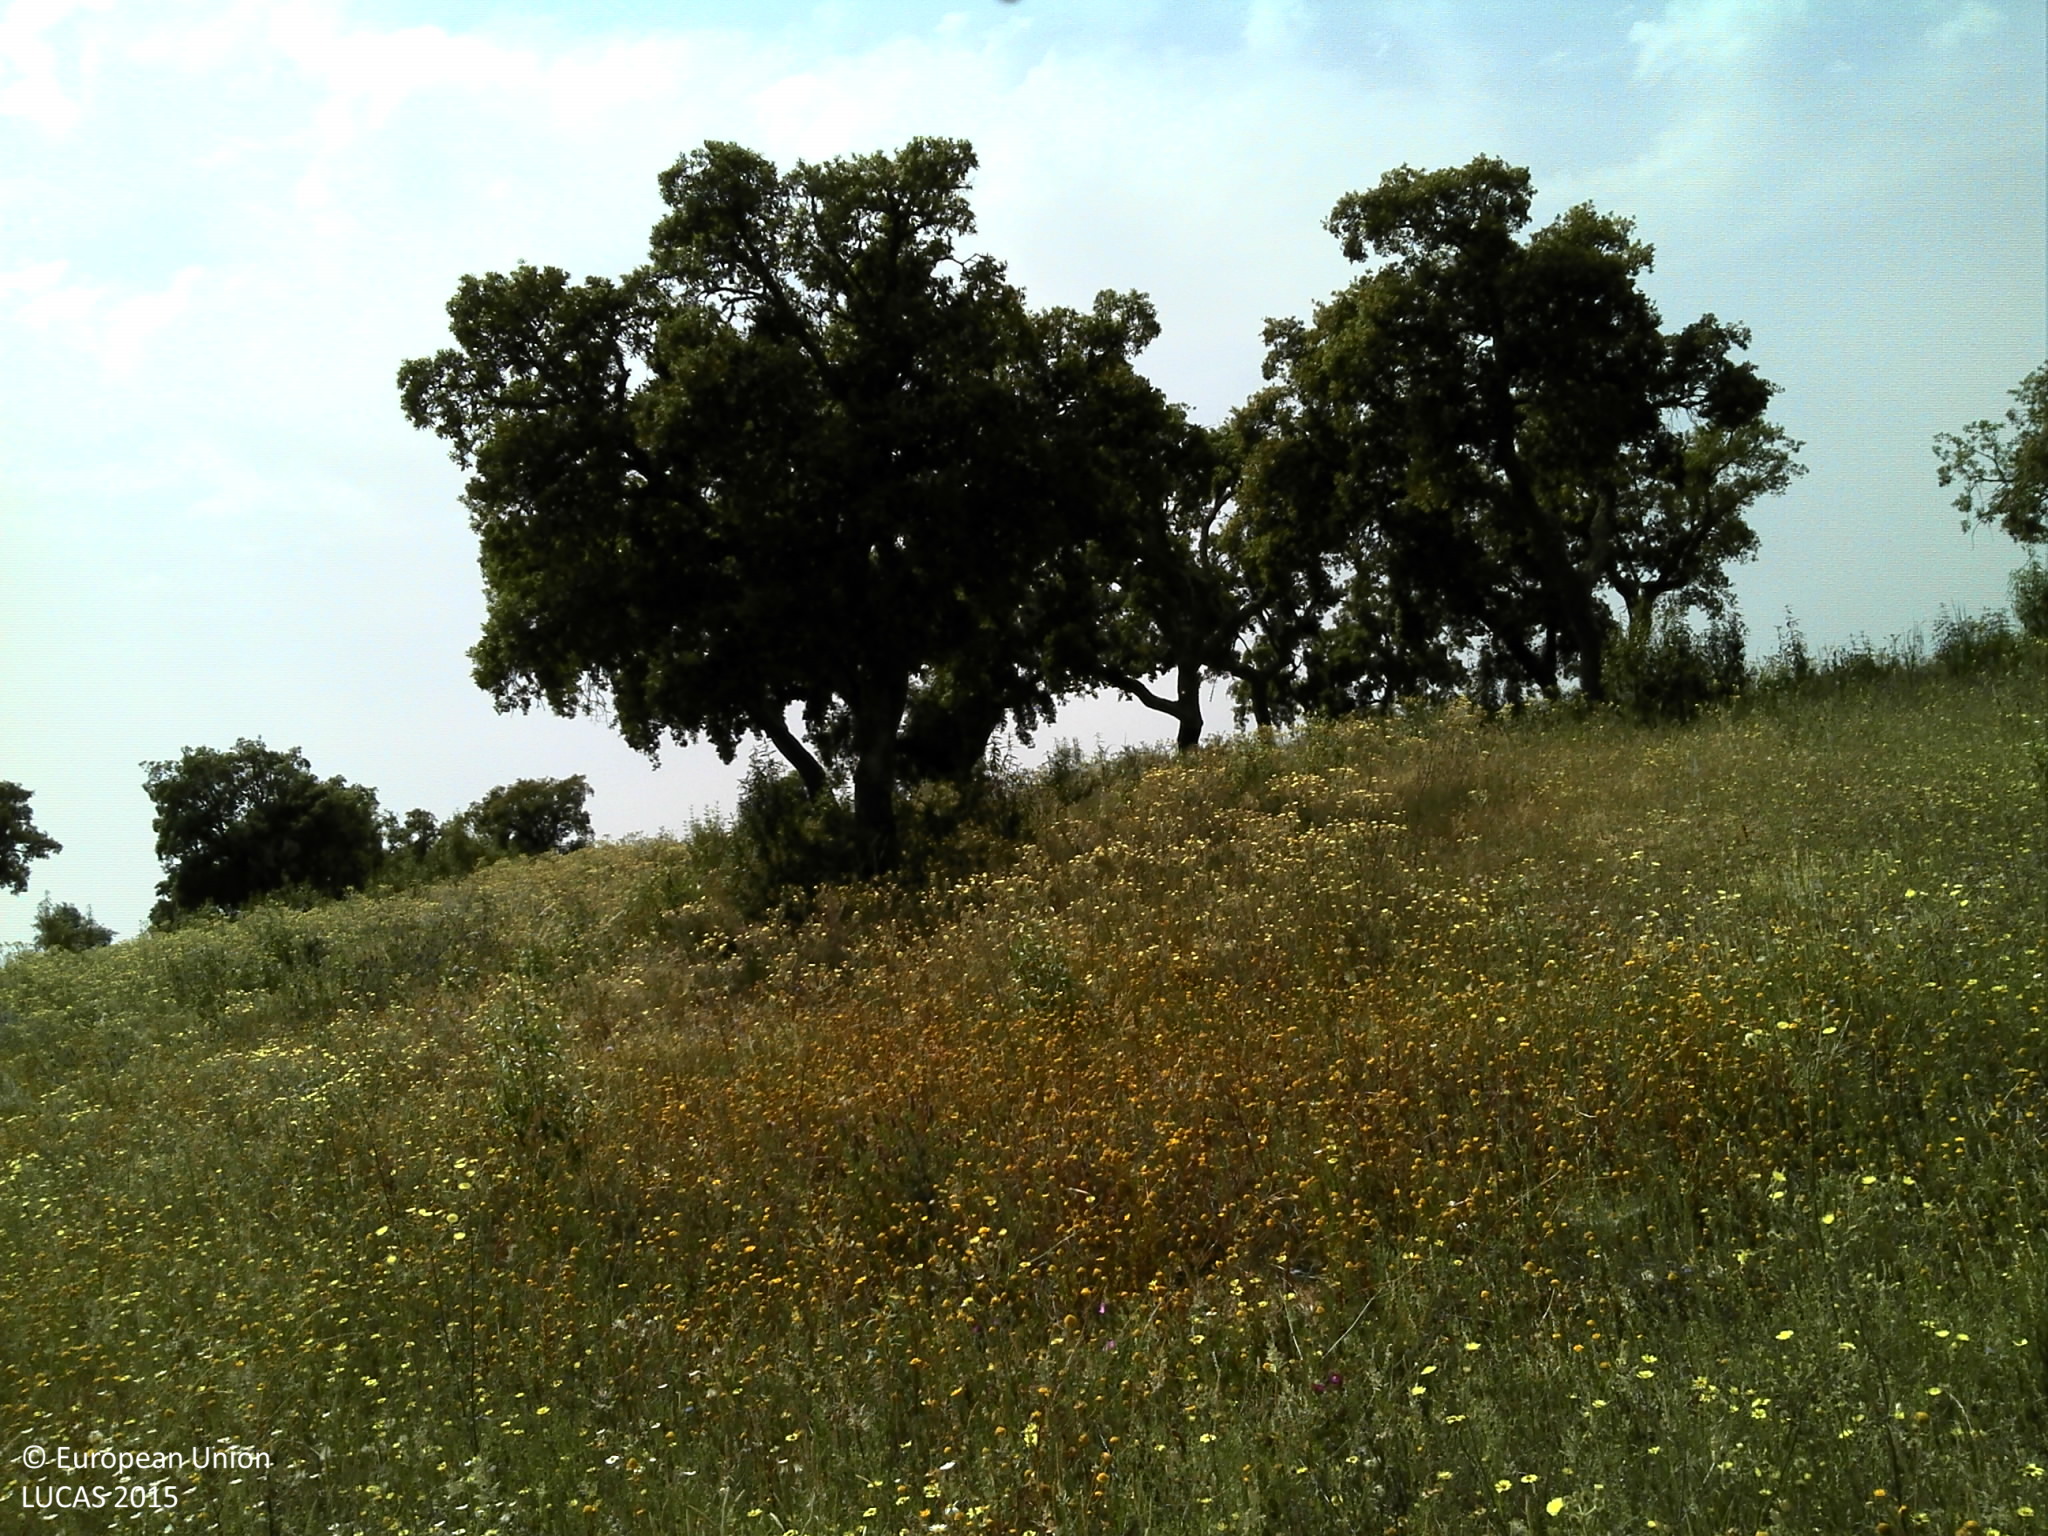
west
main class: Woodland
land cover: Broadleaved woodland
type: broadleaved evergreen forest
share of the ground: 10 - 25 %
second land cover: Grassland without tree/shrub cover
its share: 10 - 25 %
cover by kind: herbaceous plants 30 %, unconsolidated bare surface 30 %, shrubs 25 %, broadleaved forest trees 15 %
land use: Forestry
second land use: Agriculture (excluding fallow land and kitchen gardens)
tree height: > 5 m
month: May
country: PT
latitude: 39.0058
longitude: -7.9357
